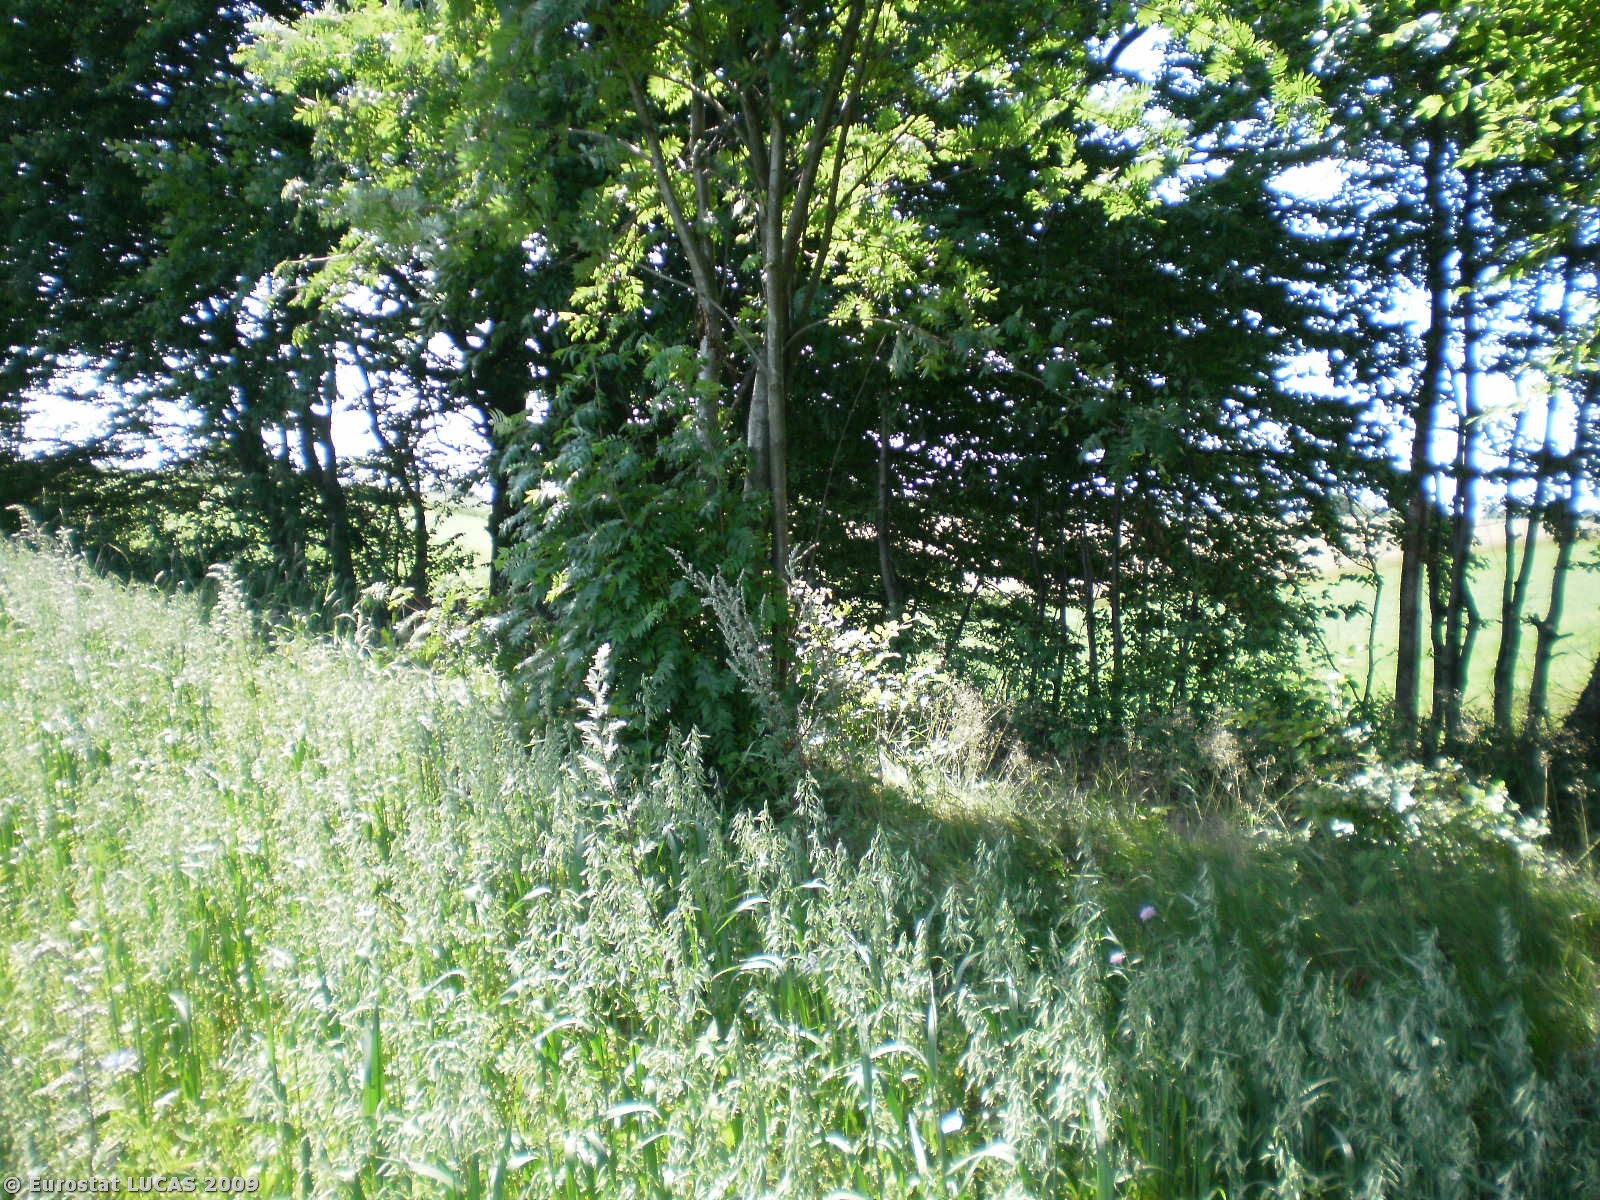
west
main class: Cropland
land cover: Oats
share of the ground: > 75 %
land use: Agriculture (excluding fallow land and kitchen gardens)
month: July
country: PL
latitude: 54.2803
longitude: 17.9232
